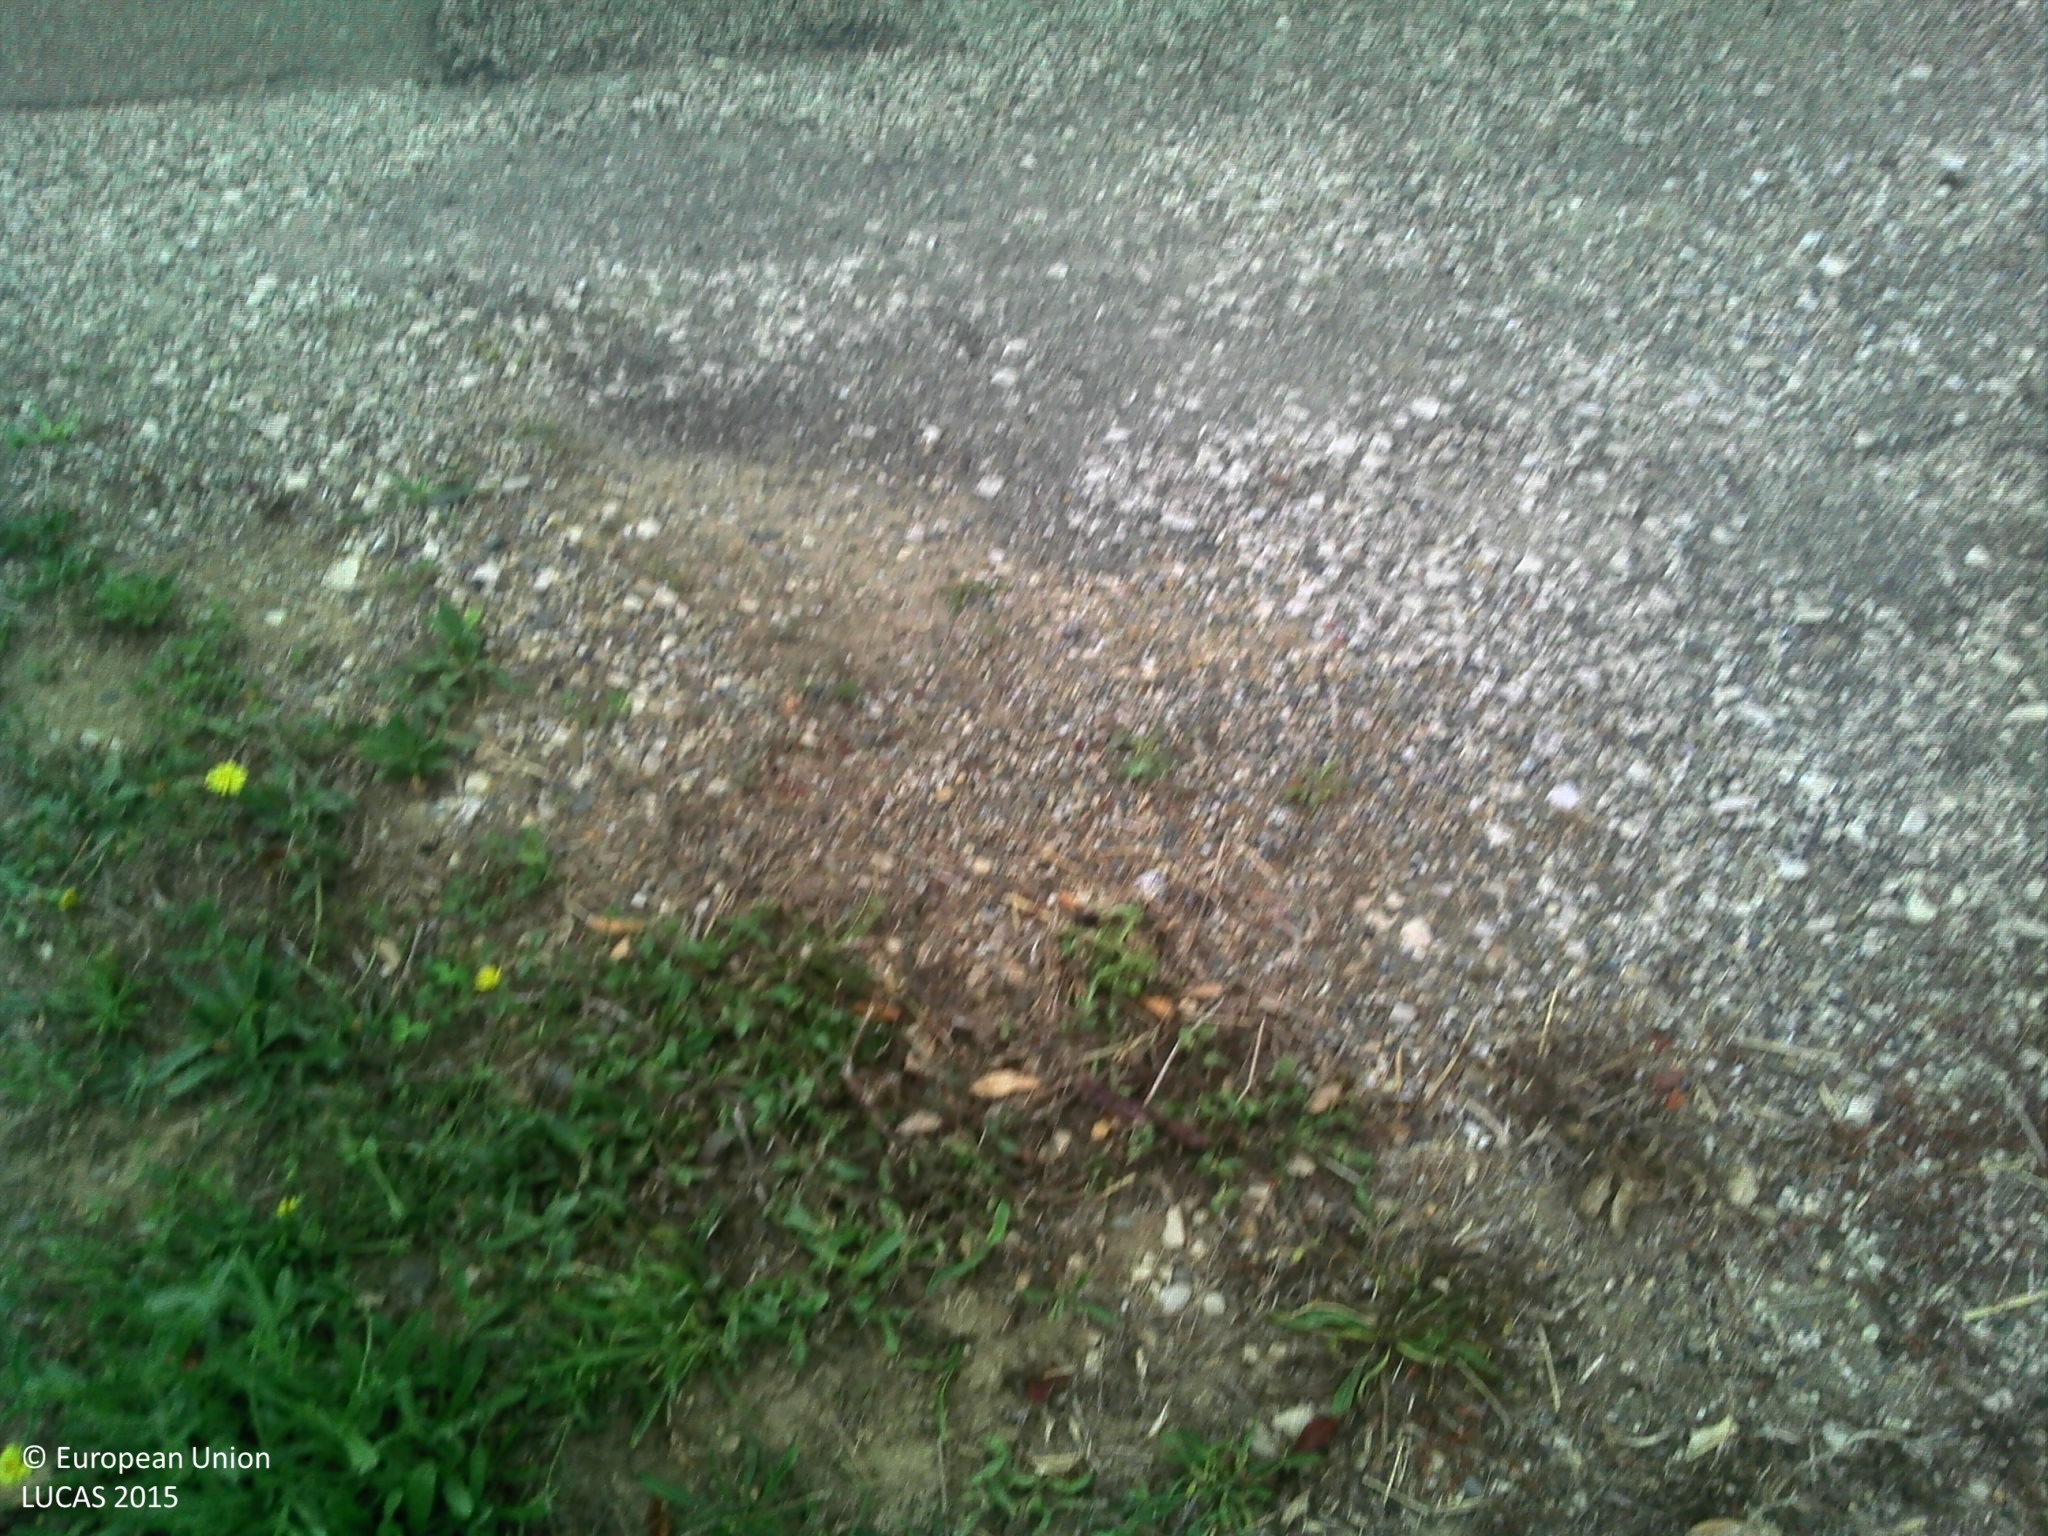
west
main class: Grassland
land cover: Grassland with sparse tree/shrub cover
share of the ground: > 75 %
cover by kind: herbaceous plants 95 %, broadleaved forest trees 5 %
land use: Residential
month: August
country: FR
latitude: 43.9096
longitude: 1.2712
